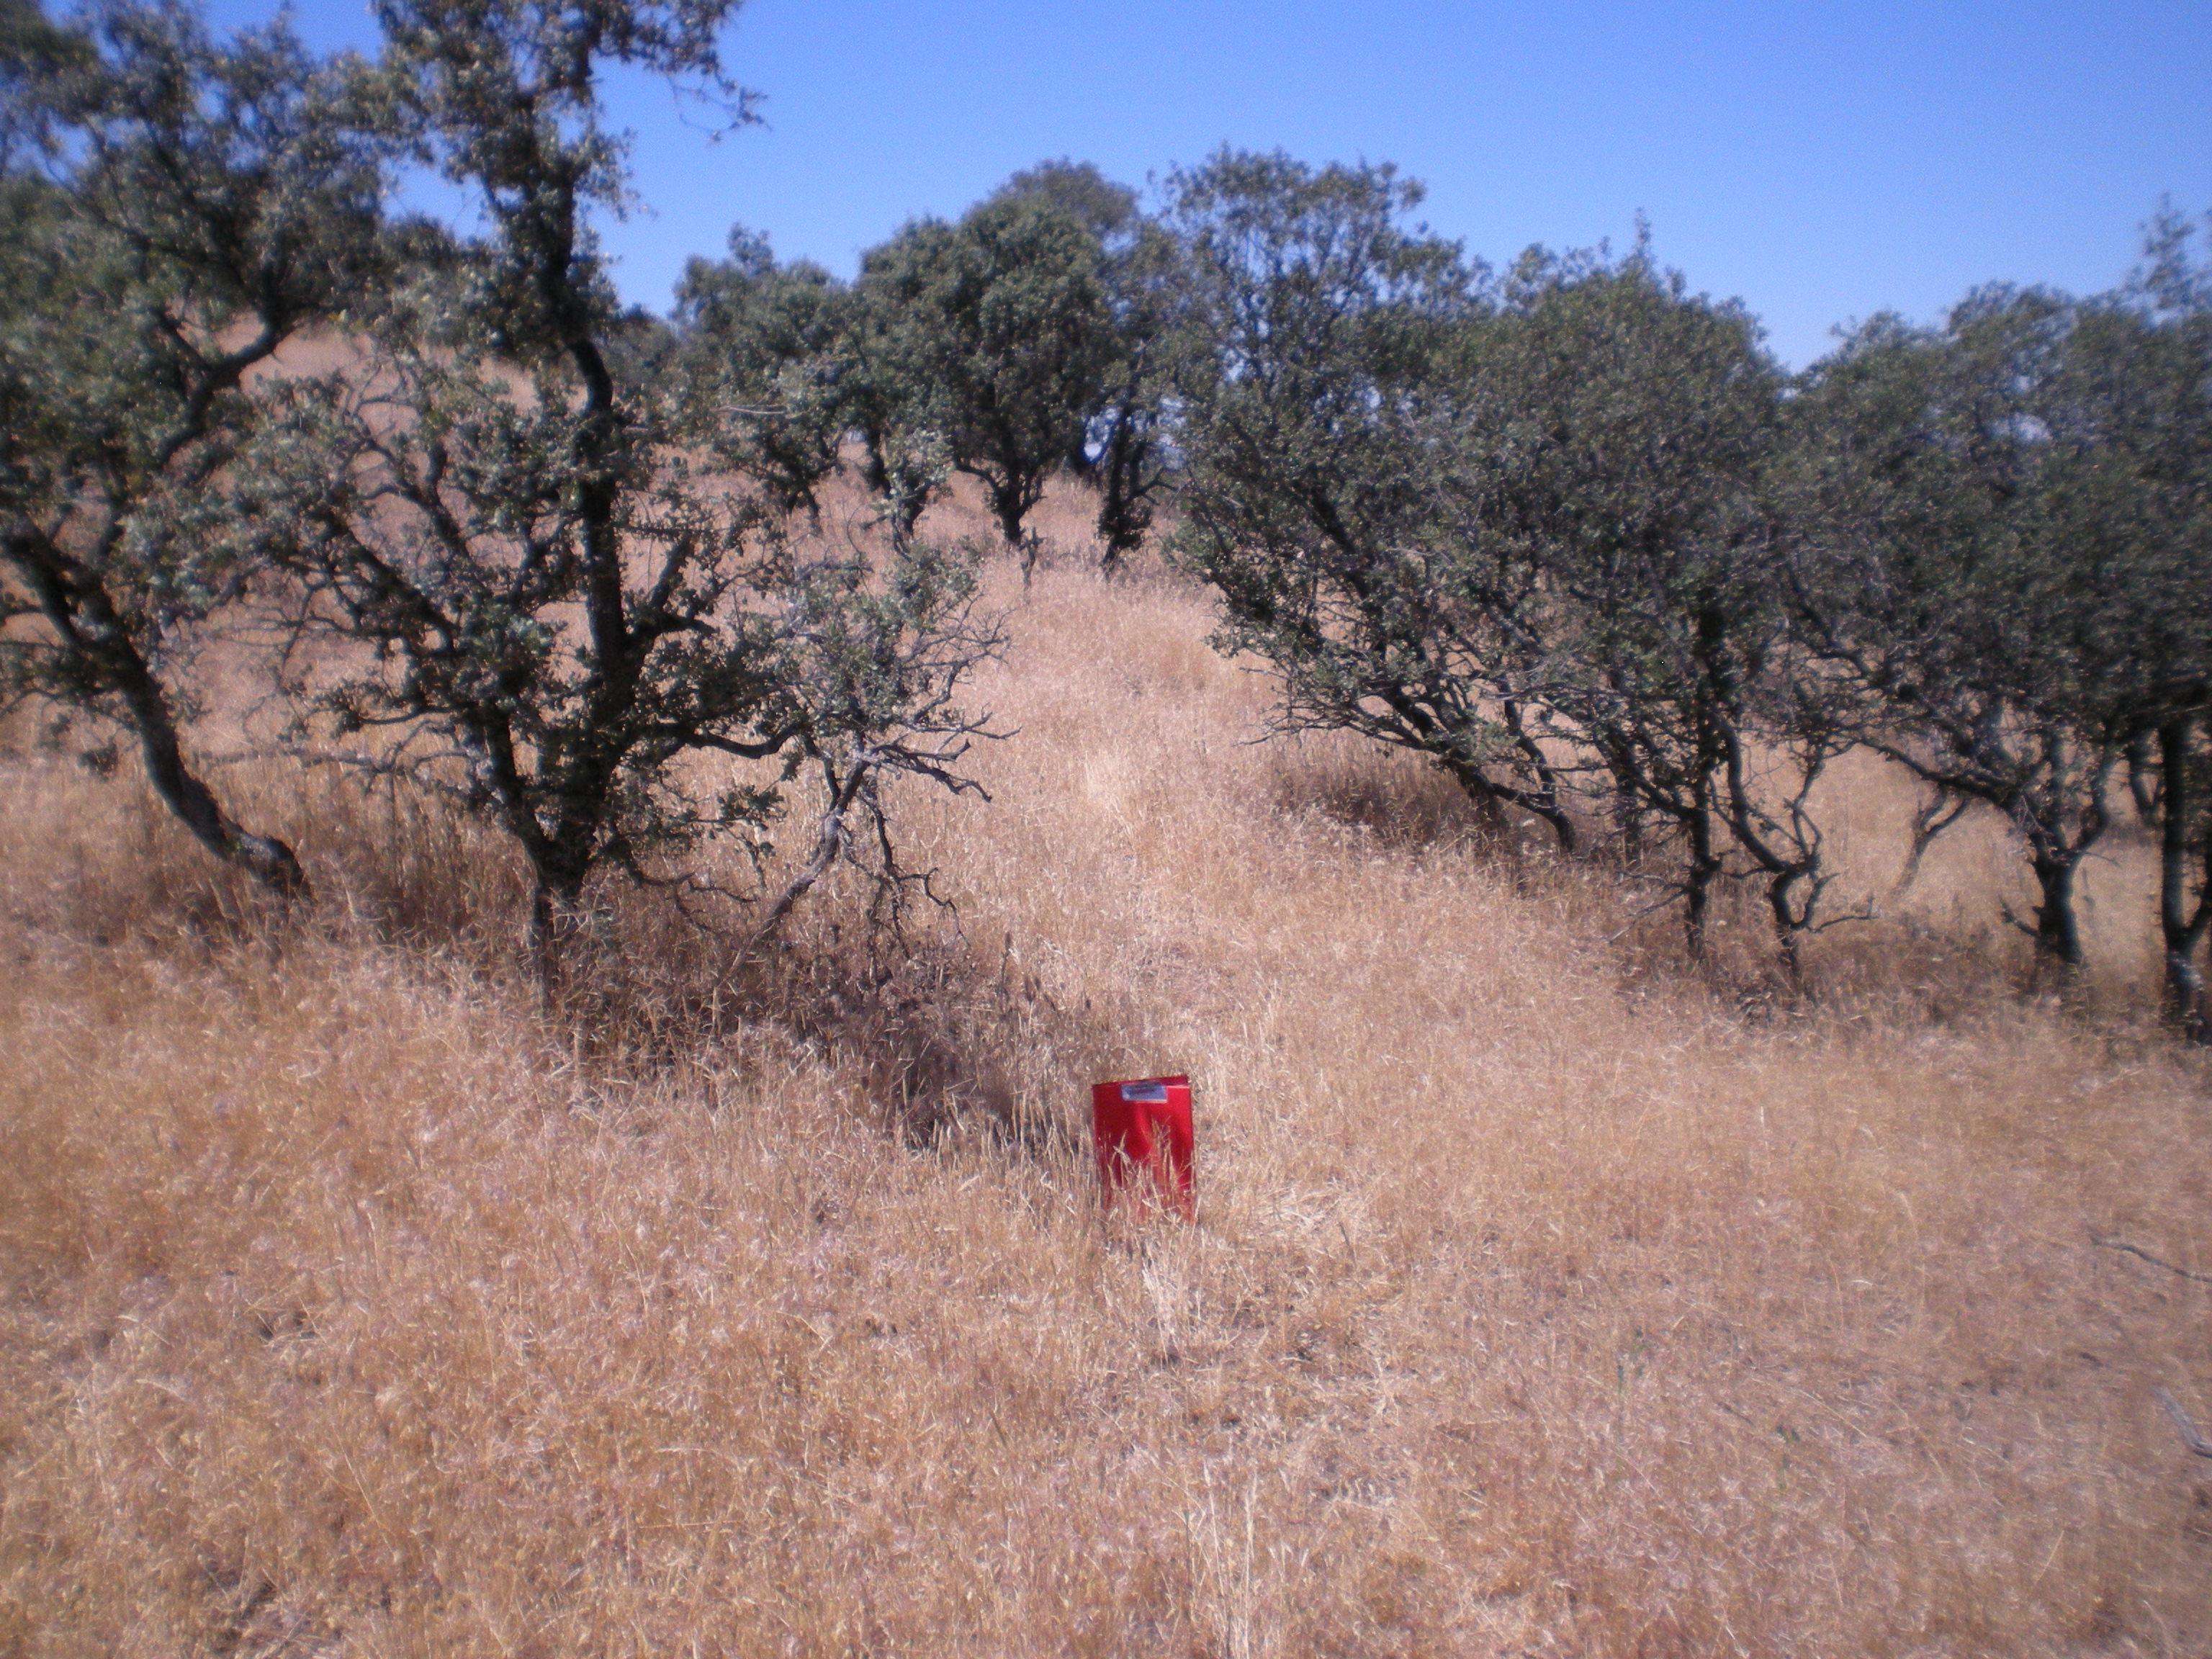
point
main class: Woodland
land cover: Broadleaved woodland
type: broadleaved evergreen forest
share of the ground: 25 - 50 %
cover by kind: unconsolidated bare surface 50 %, broadleaved forest trees 40 %, shrubs 5 %, herbaceous plants 5 %
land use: Semi-natural and natural areas not in use
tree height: < 5 m
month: May
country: ES
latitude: 38.4875
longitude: -3.3629
